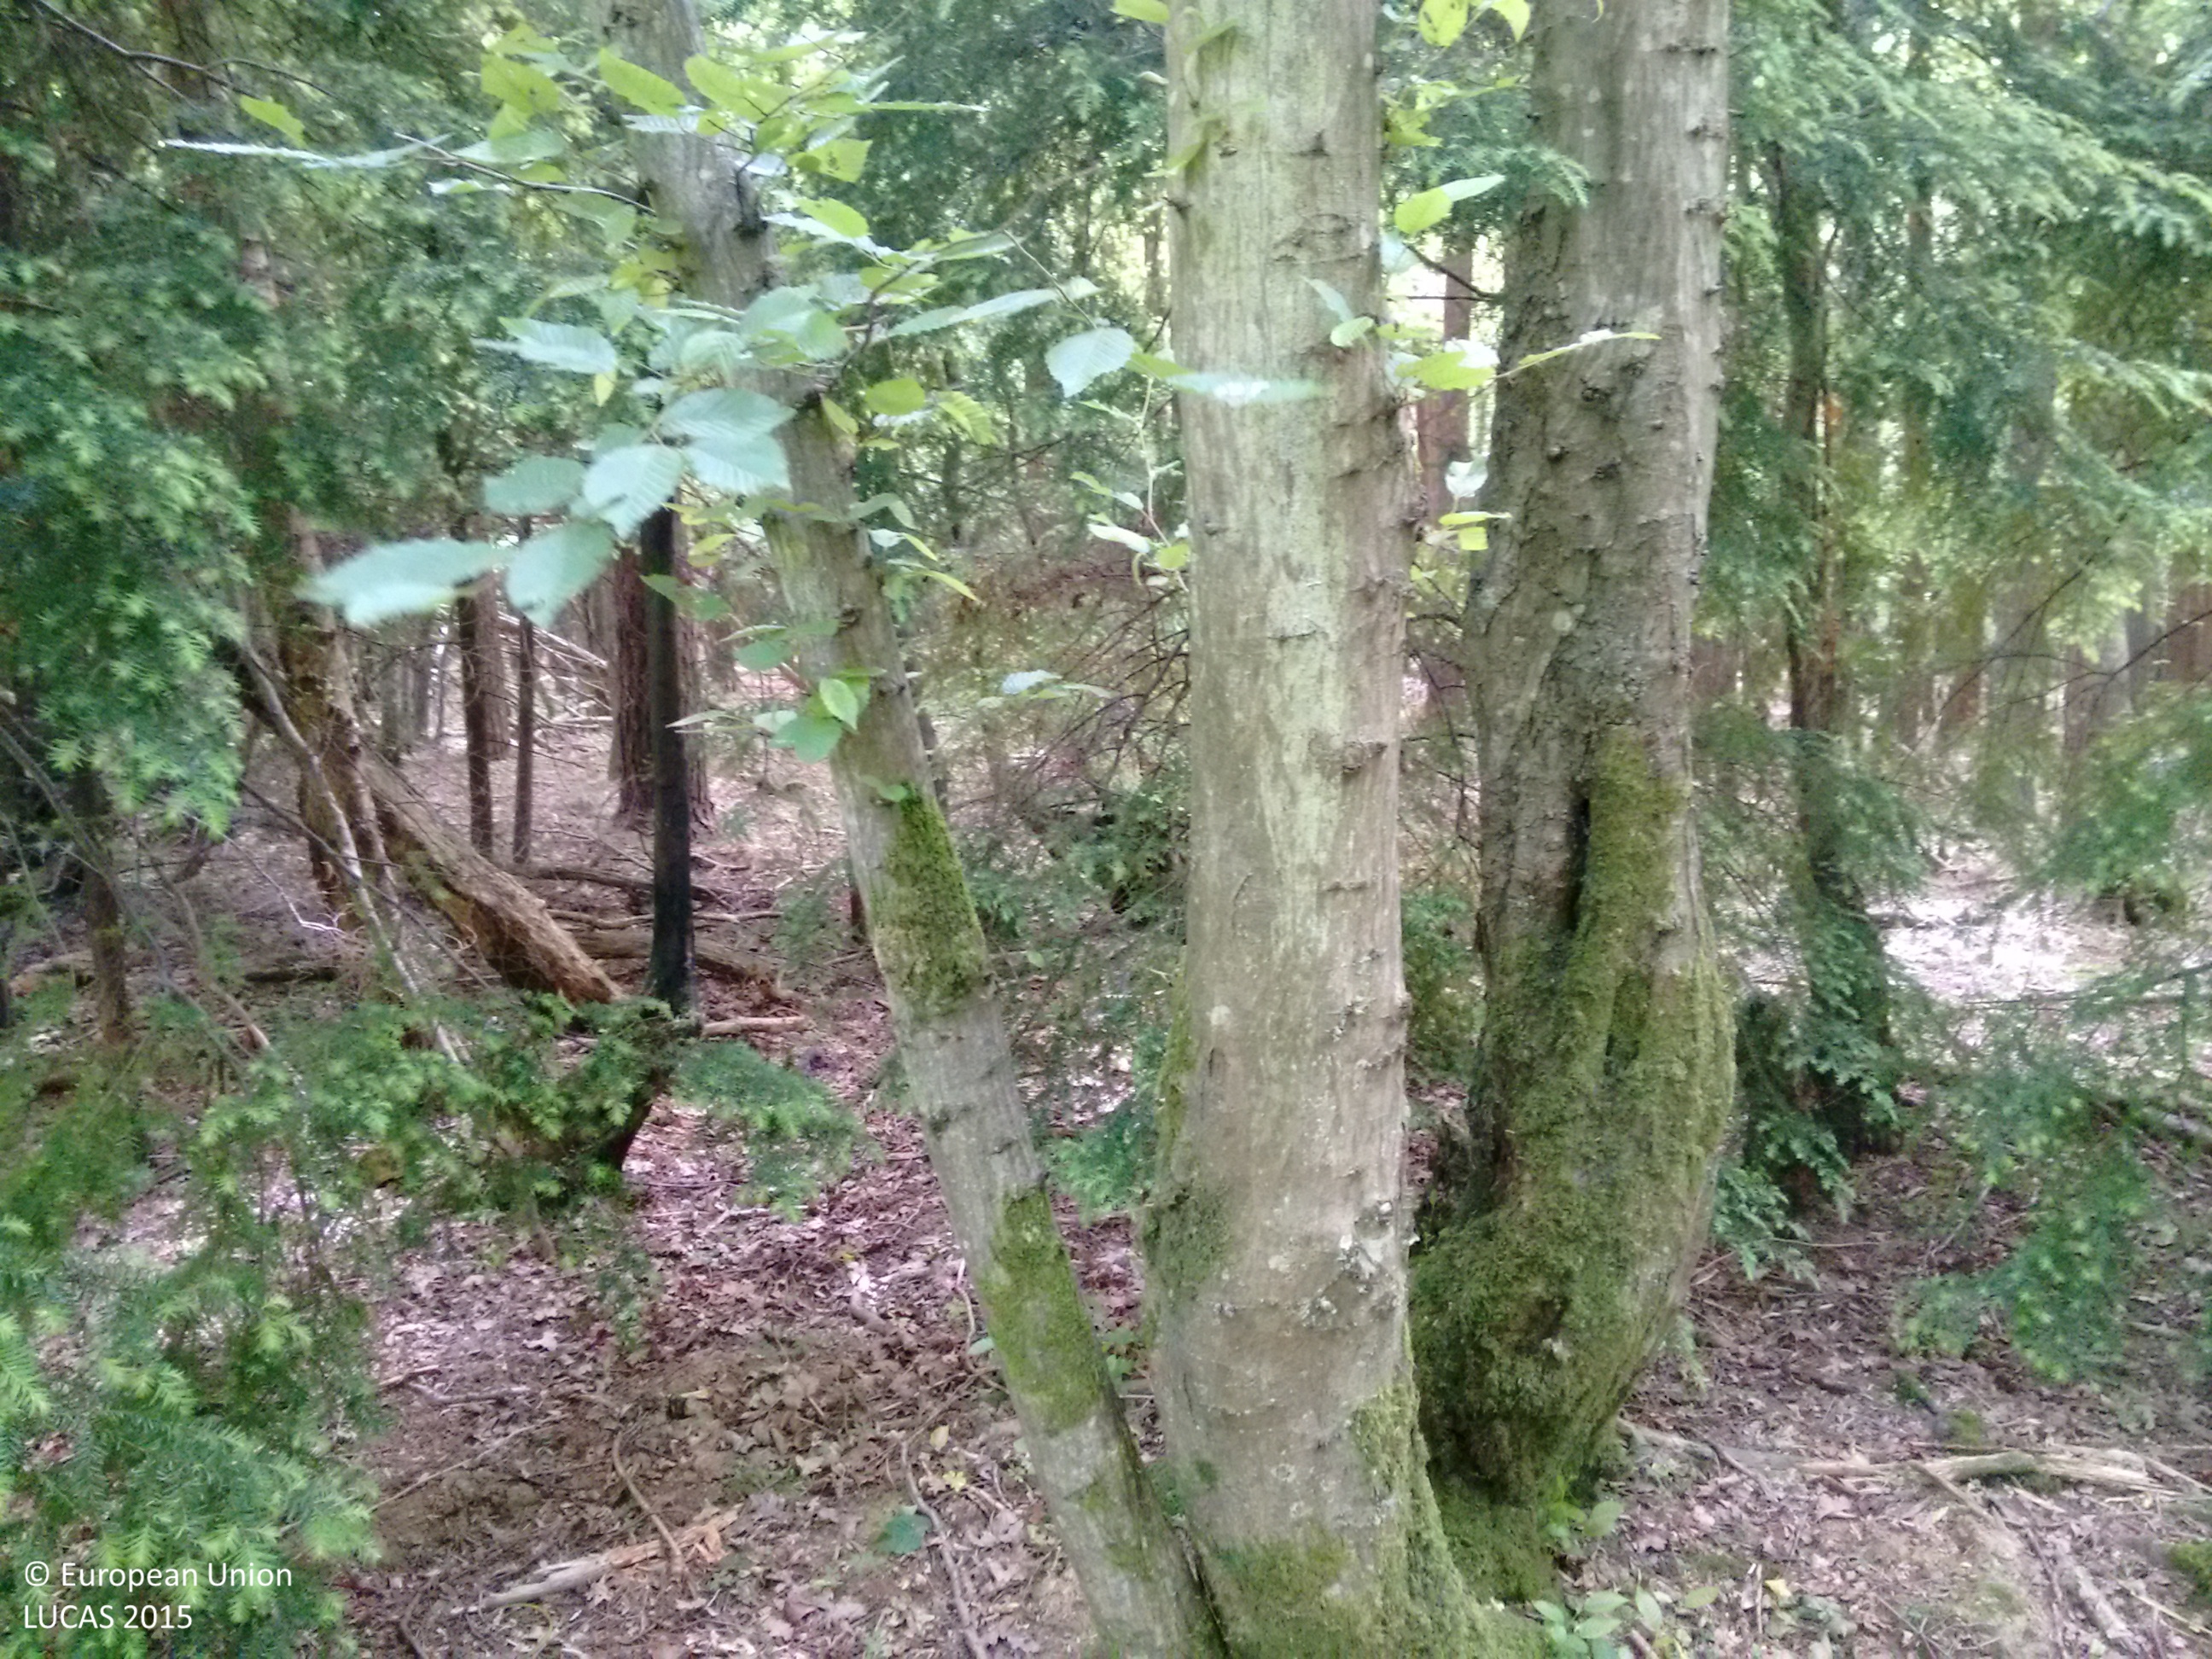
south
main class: Woodland
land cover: Other mixed woodland
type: exotic forest
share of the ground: > 75 %
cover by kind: coniferous forest trees 70 %, broadleaved forest trees 30 %
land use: Forestry
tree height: > 5 m
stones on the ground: < 10 %
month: June
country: GB
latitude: 50.9439
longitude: 0.4789
